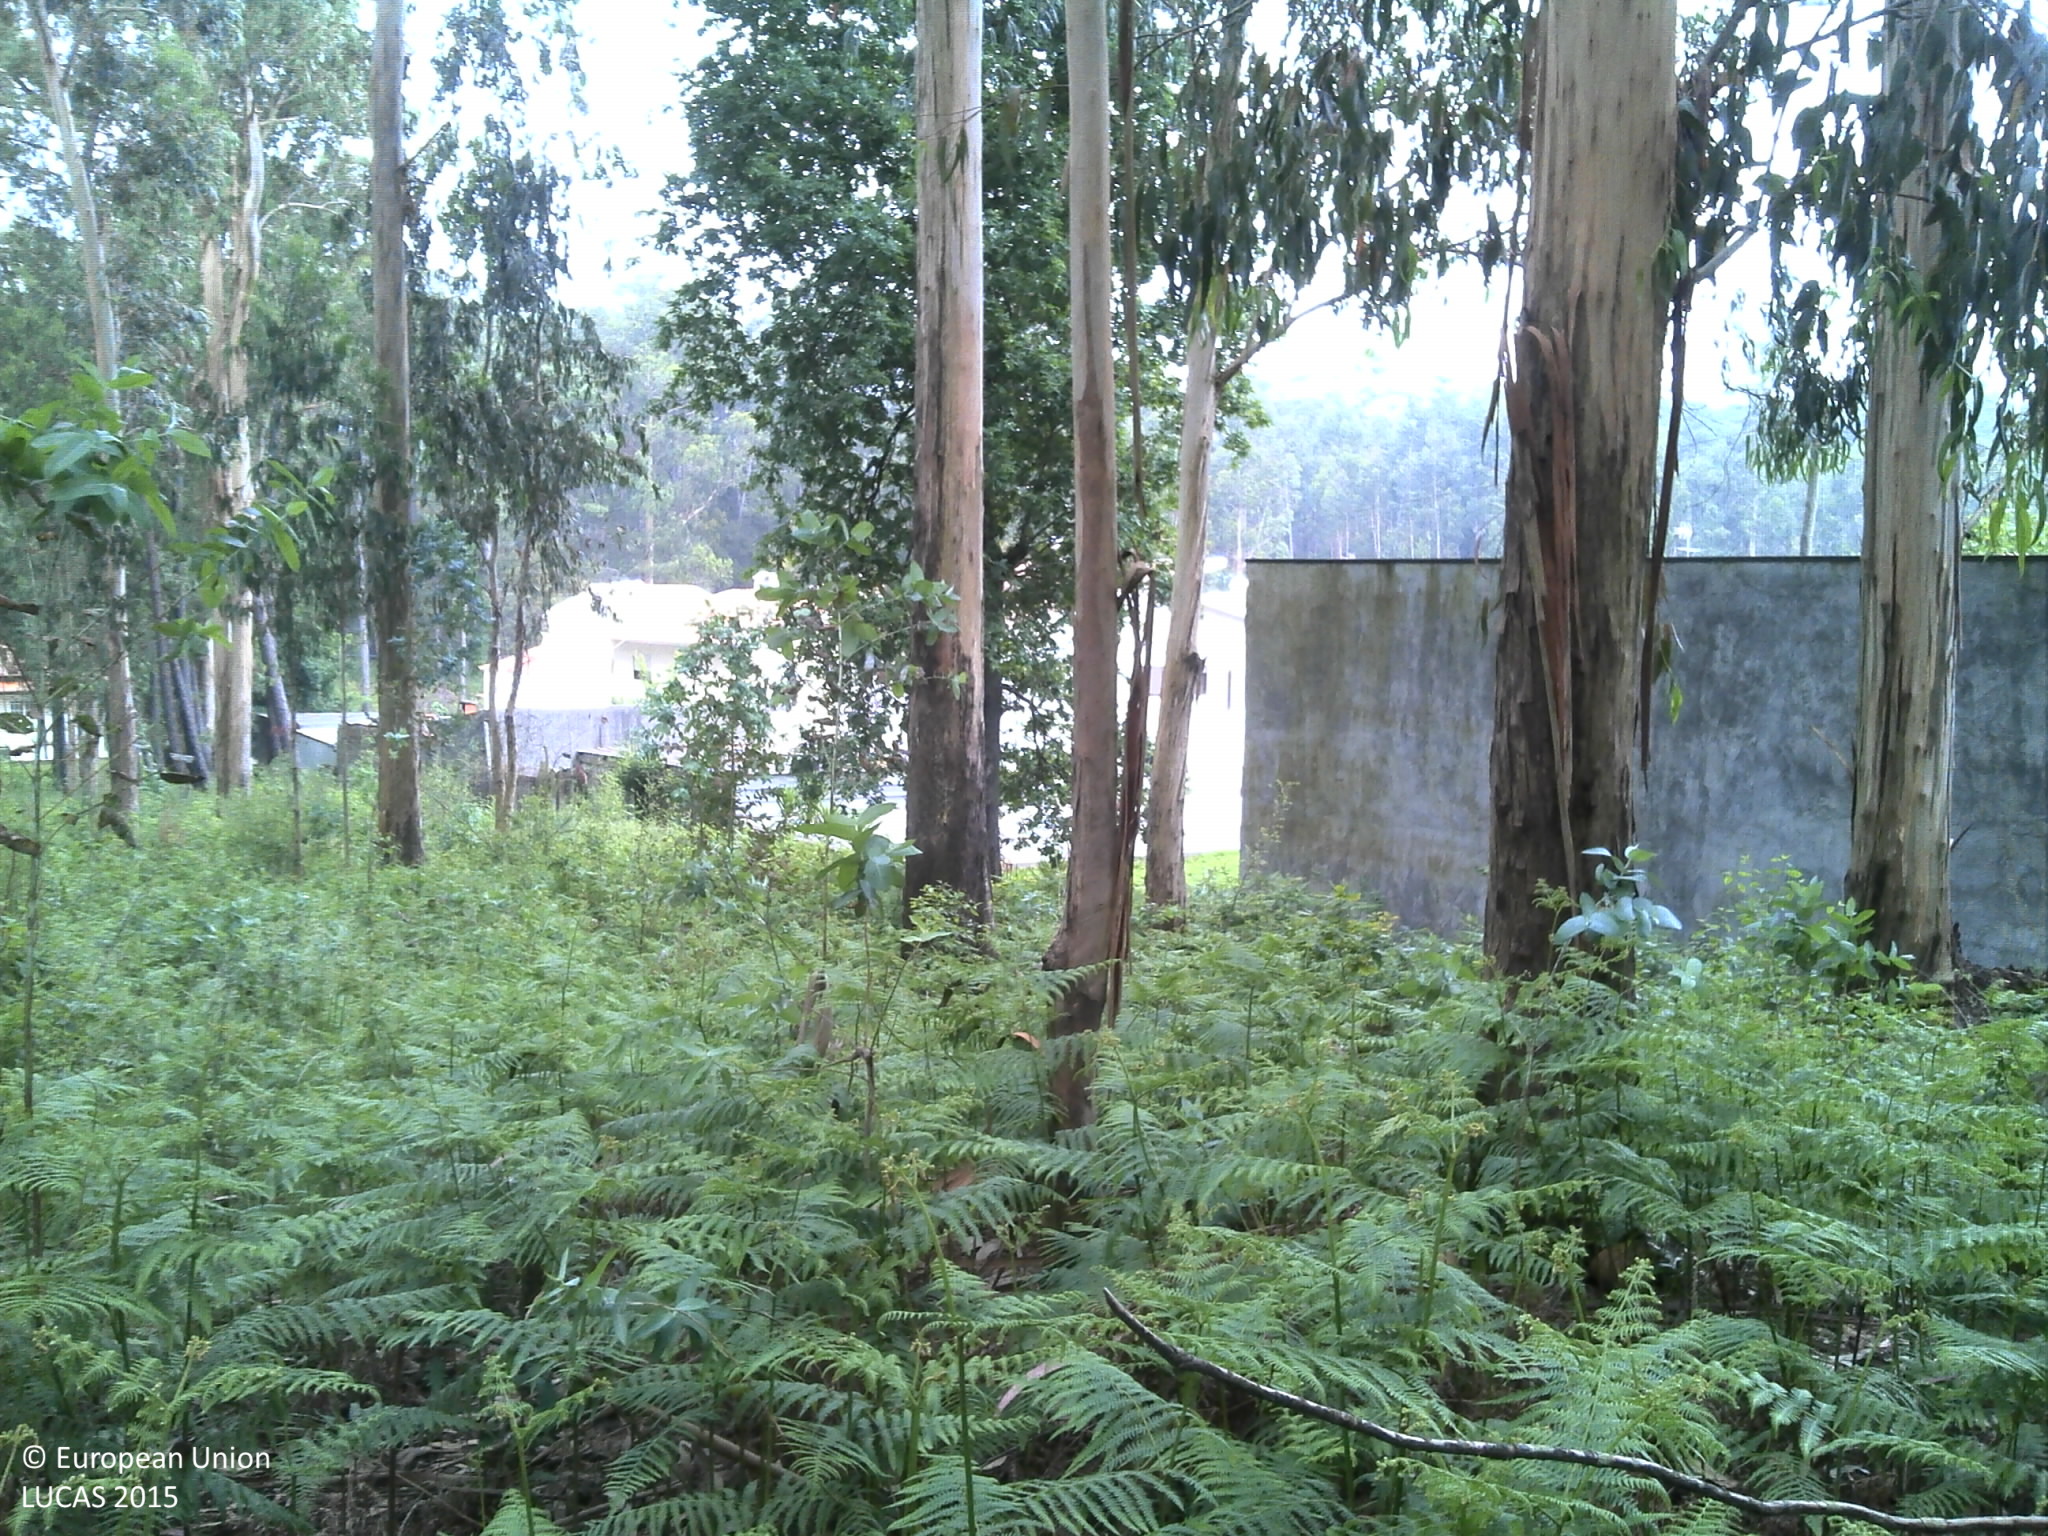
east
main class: Woodland
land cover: Broadleaved woodland
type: exotic forest
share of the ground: > 75 %
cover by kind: broadleaved forest trees 80 %, shrubs 10 %, herbaceous plants 5 %, unconsolidated bare surface 5 %
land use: Forestry
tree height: > 5 m
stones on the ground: < 10 %
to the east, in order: Broadleaved woodland; Artificial constructions in urban areas; Pine dominated coniferous woodland; Broadleaved woodland; Tracks; Electric lines; Broadleaved woodland; Grass margins; Paved roads, cycling and walking lanes
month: May
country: PT
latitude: 40.9069
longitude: -8.4378
